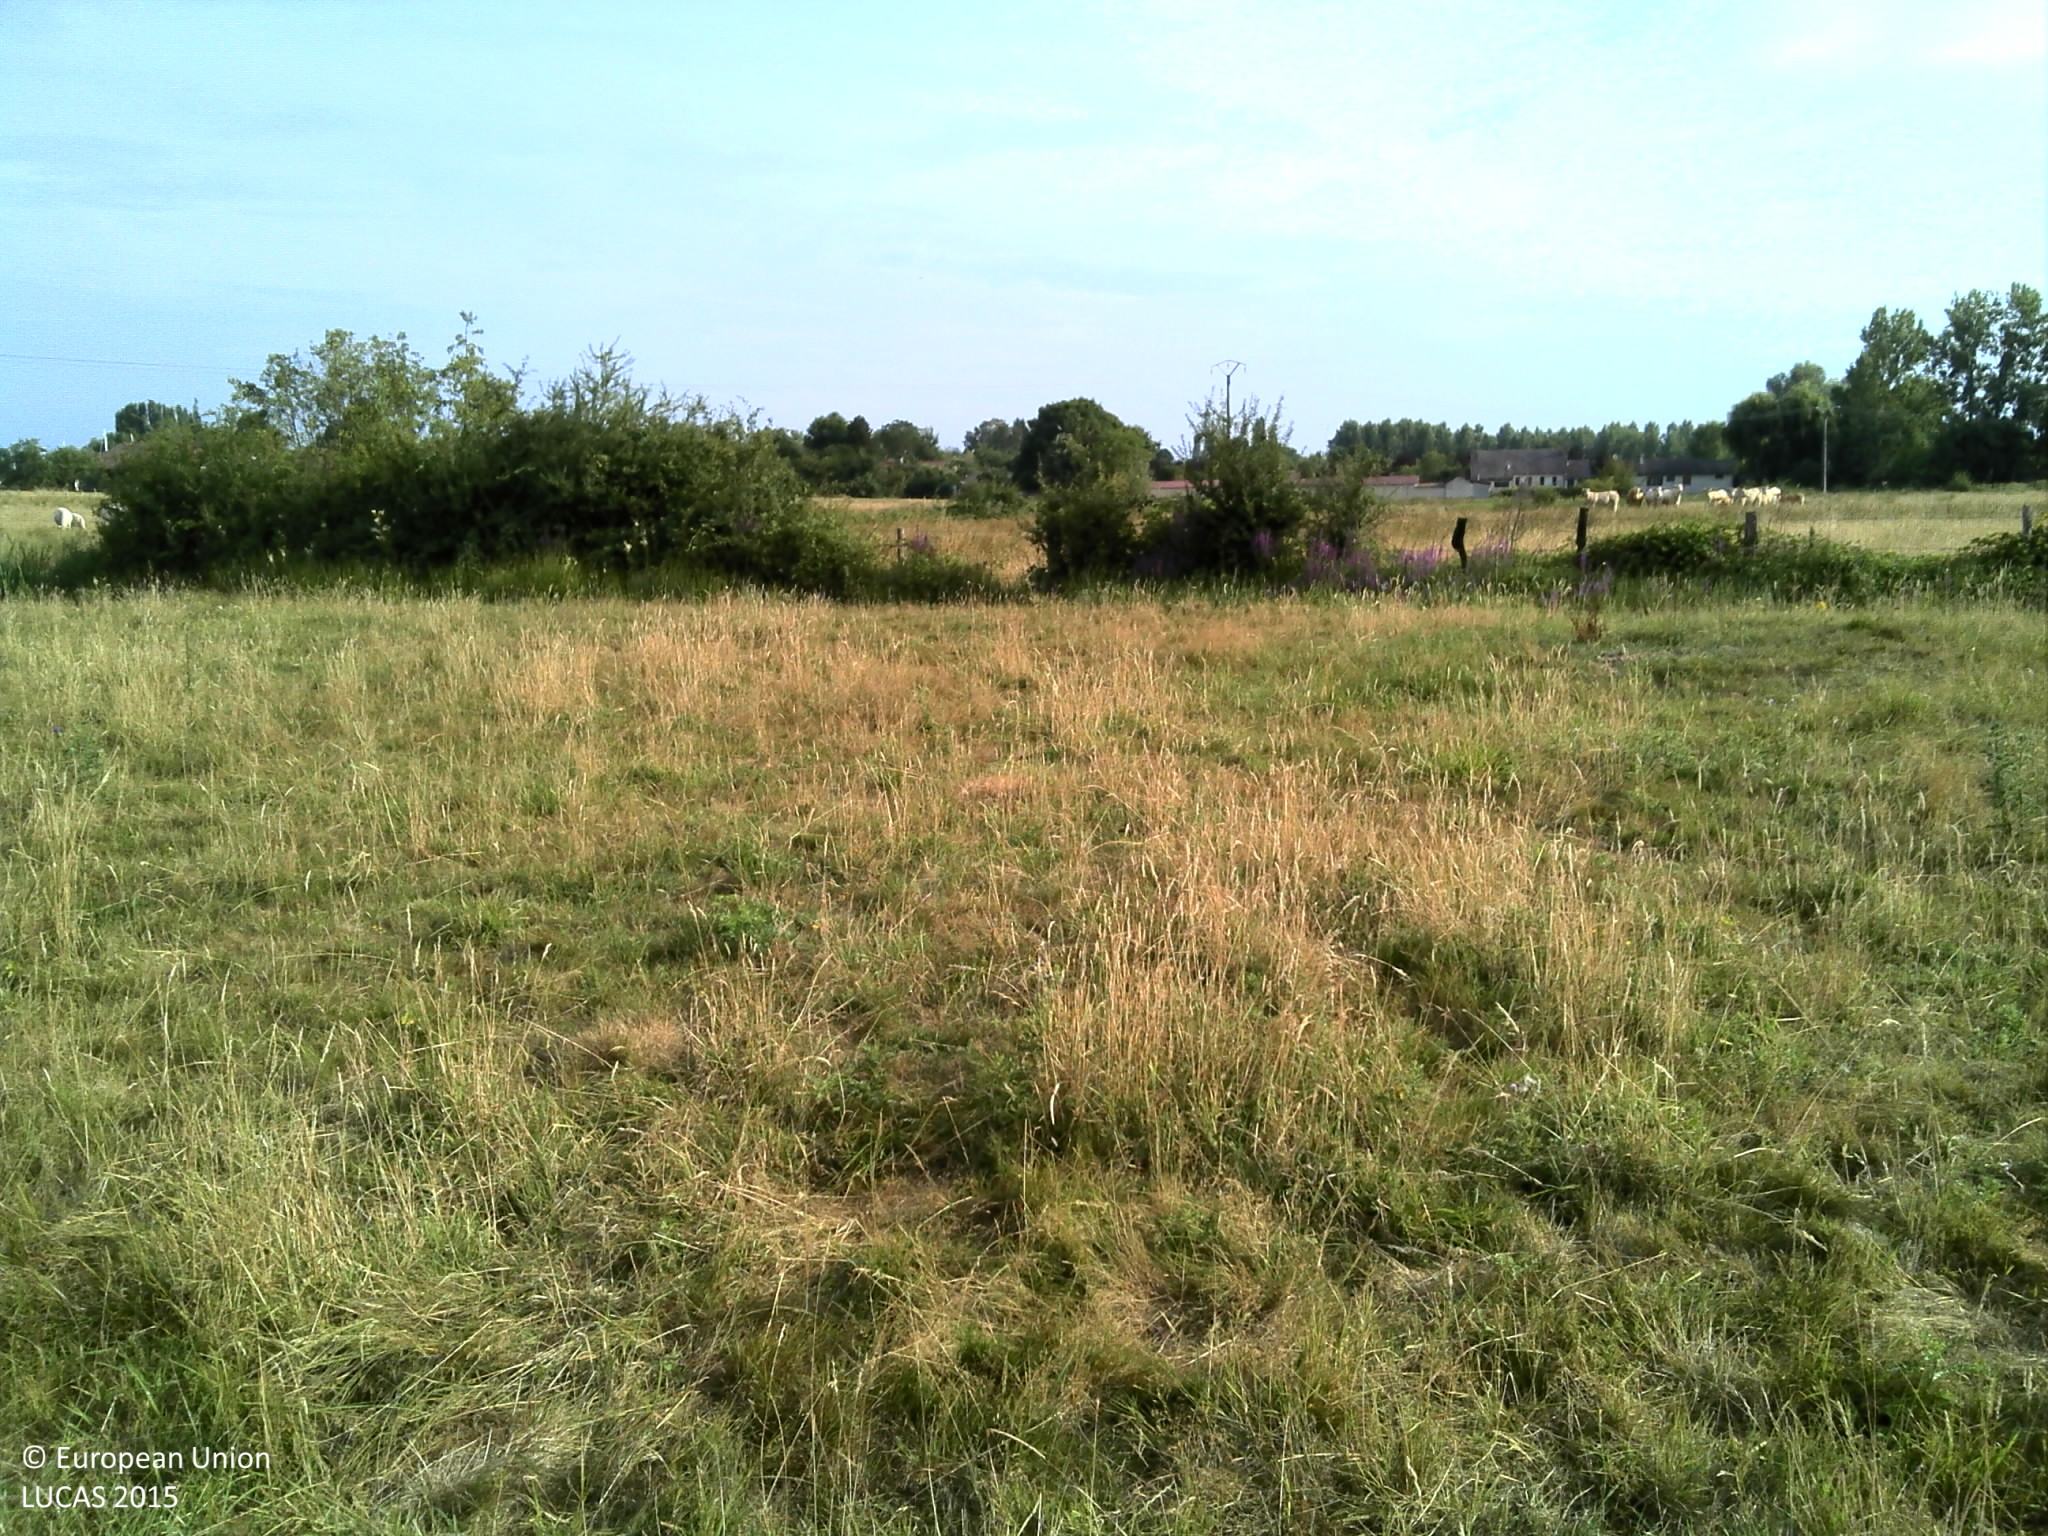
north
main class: Grassland
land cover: Grassland without tree/shrub cover
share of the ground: > 75 %
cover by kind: herbaceous plants 100 %
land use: Agriculture (excluding fallow land and kitchen gardens)
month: July
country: FR
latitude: 48.5495
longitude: 4.7551
